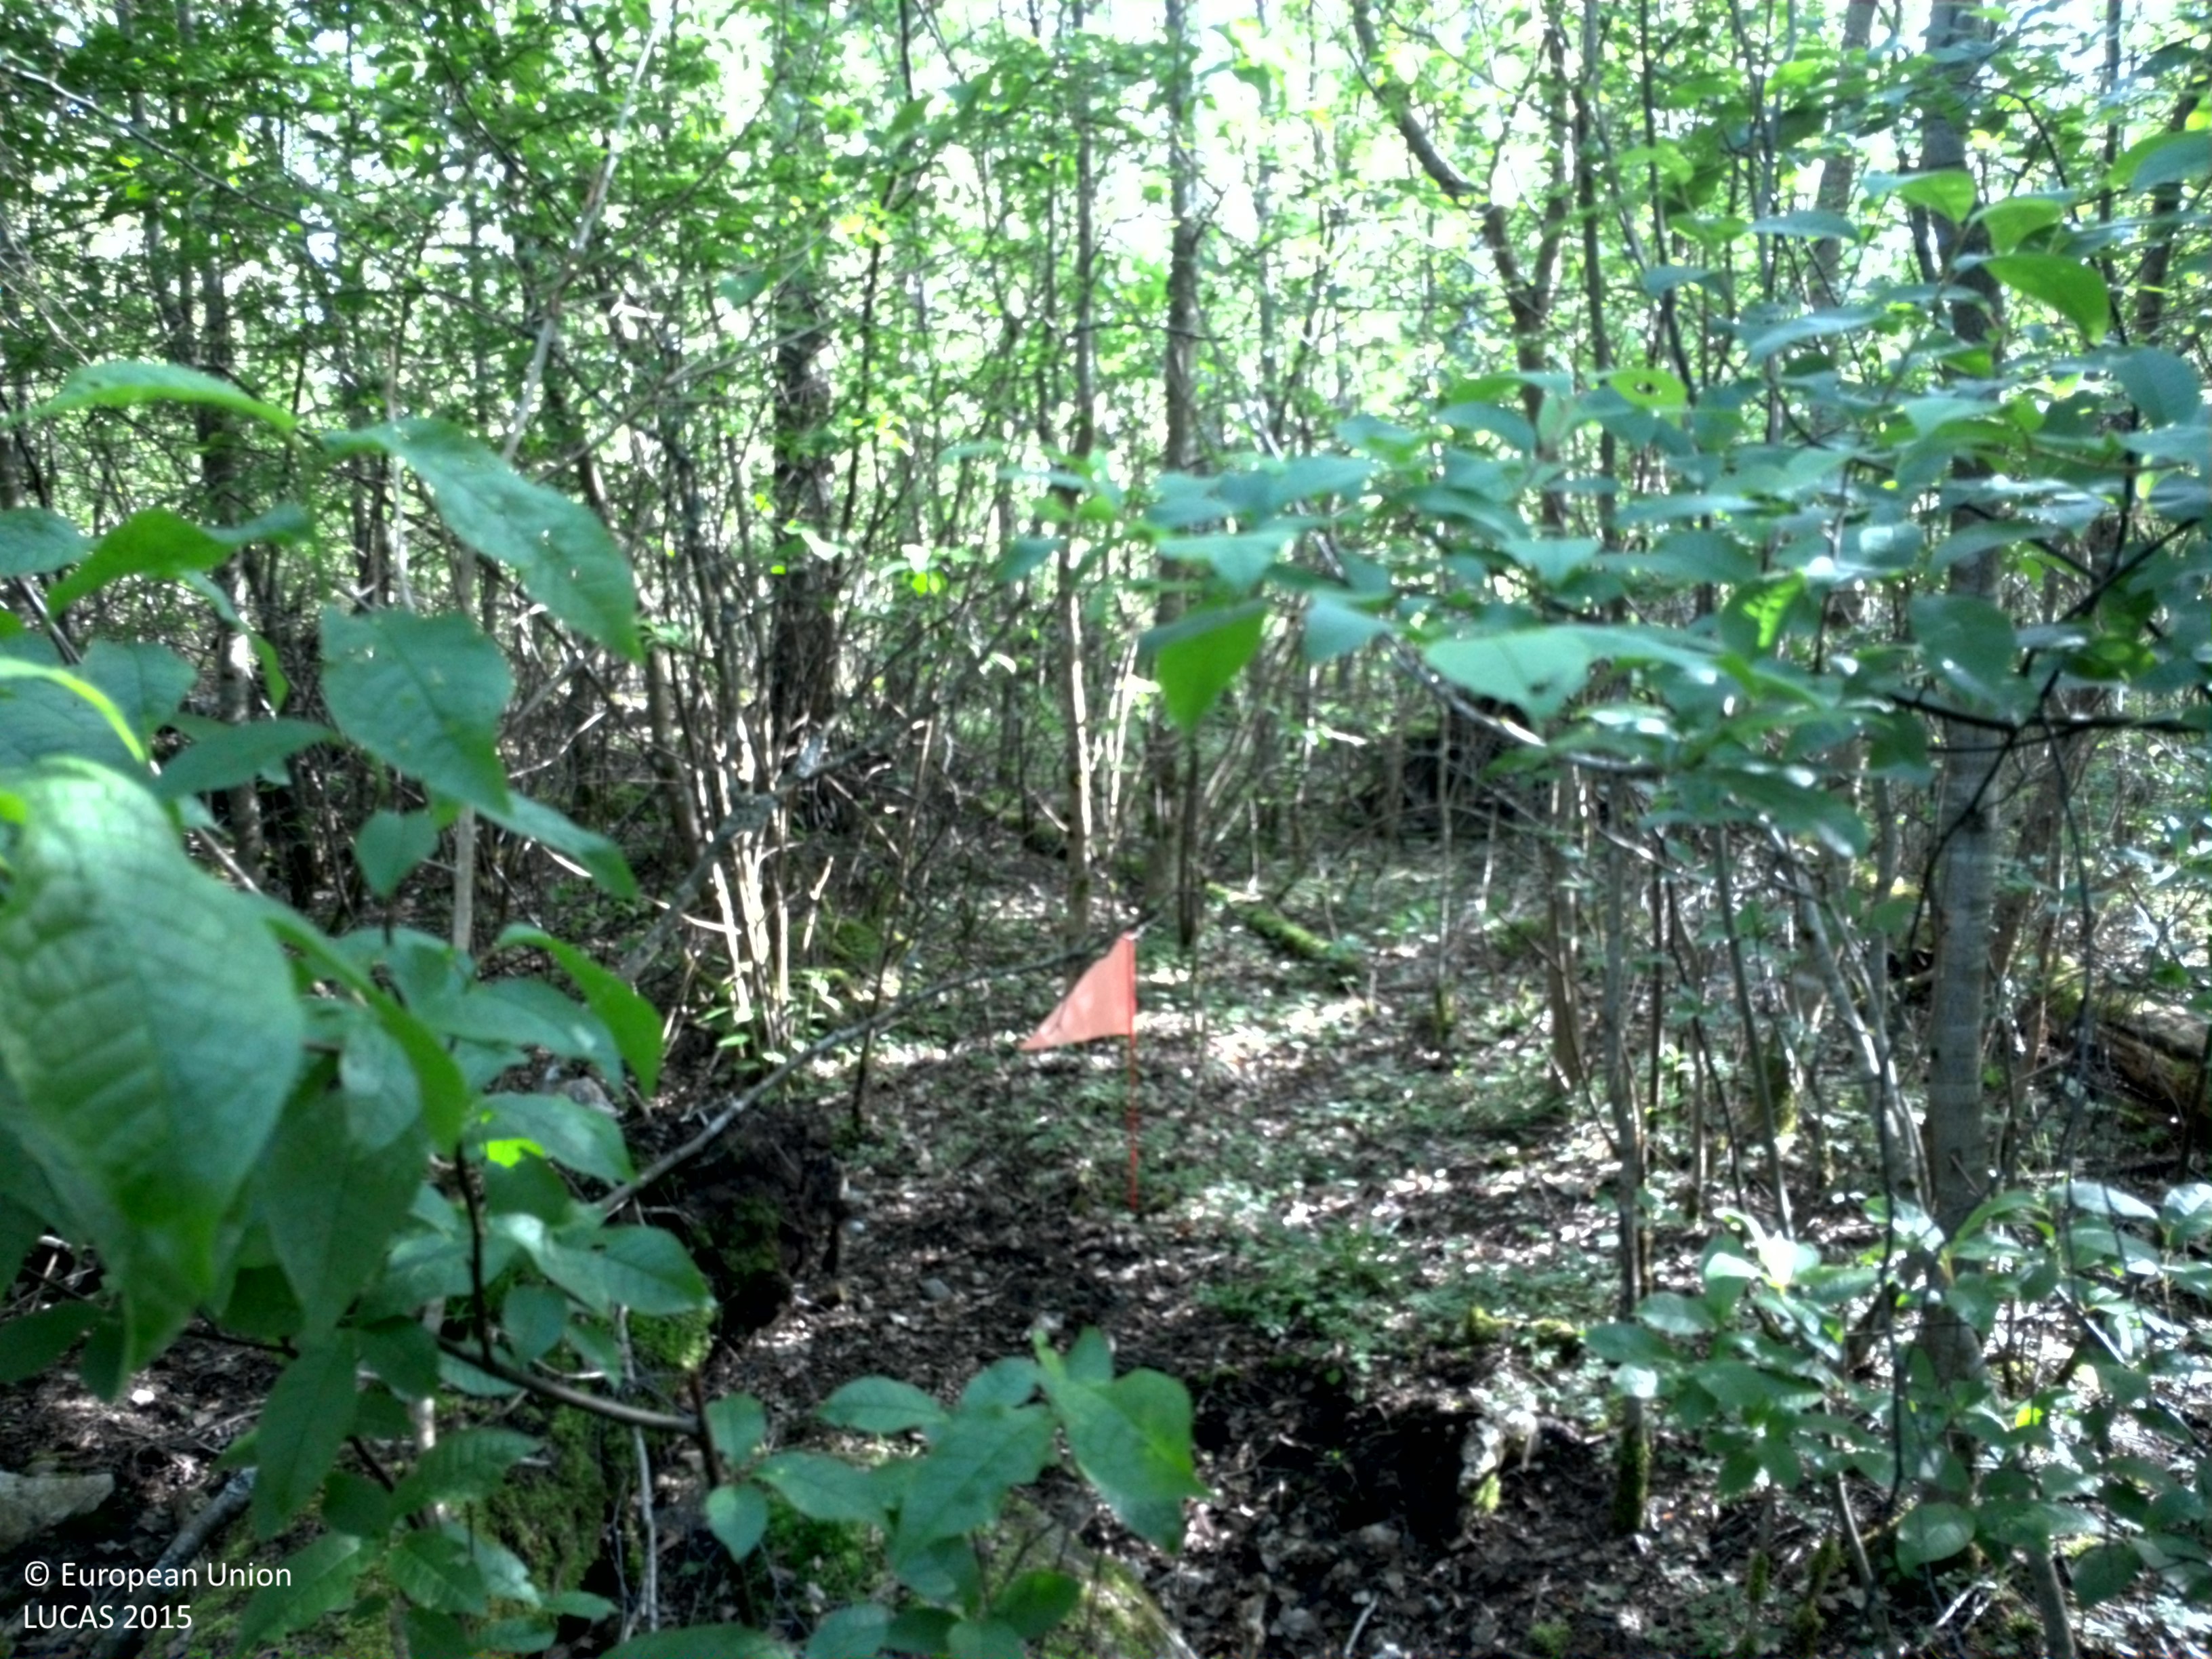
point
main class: Woodland
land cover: Broadleaved woodland
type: boreal forest
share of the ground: > 75 %
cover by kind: broadleaved forest trees 90 %, herbaceous plants 5 %, unconsolidated bare surface 5 %
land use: Forestry
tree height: > 5 m
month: June
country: SE
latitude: 56.7852
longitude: 14.7277
